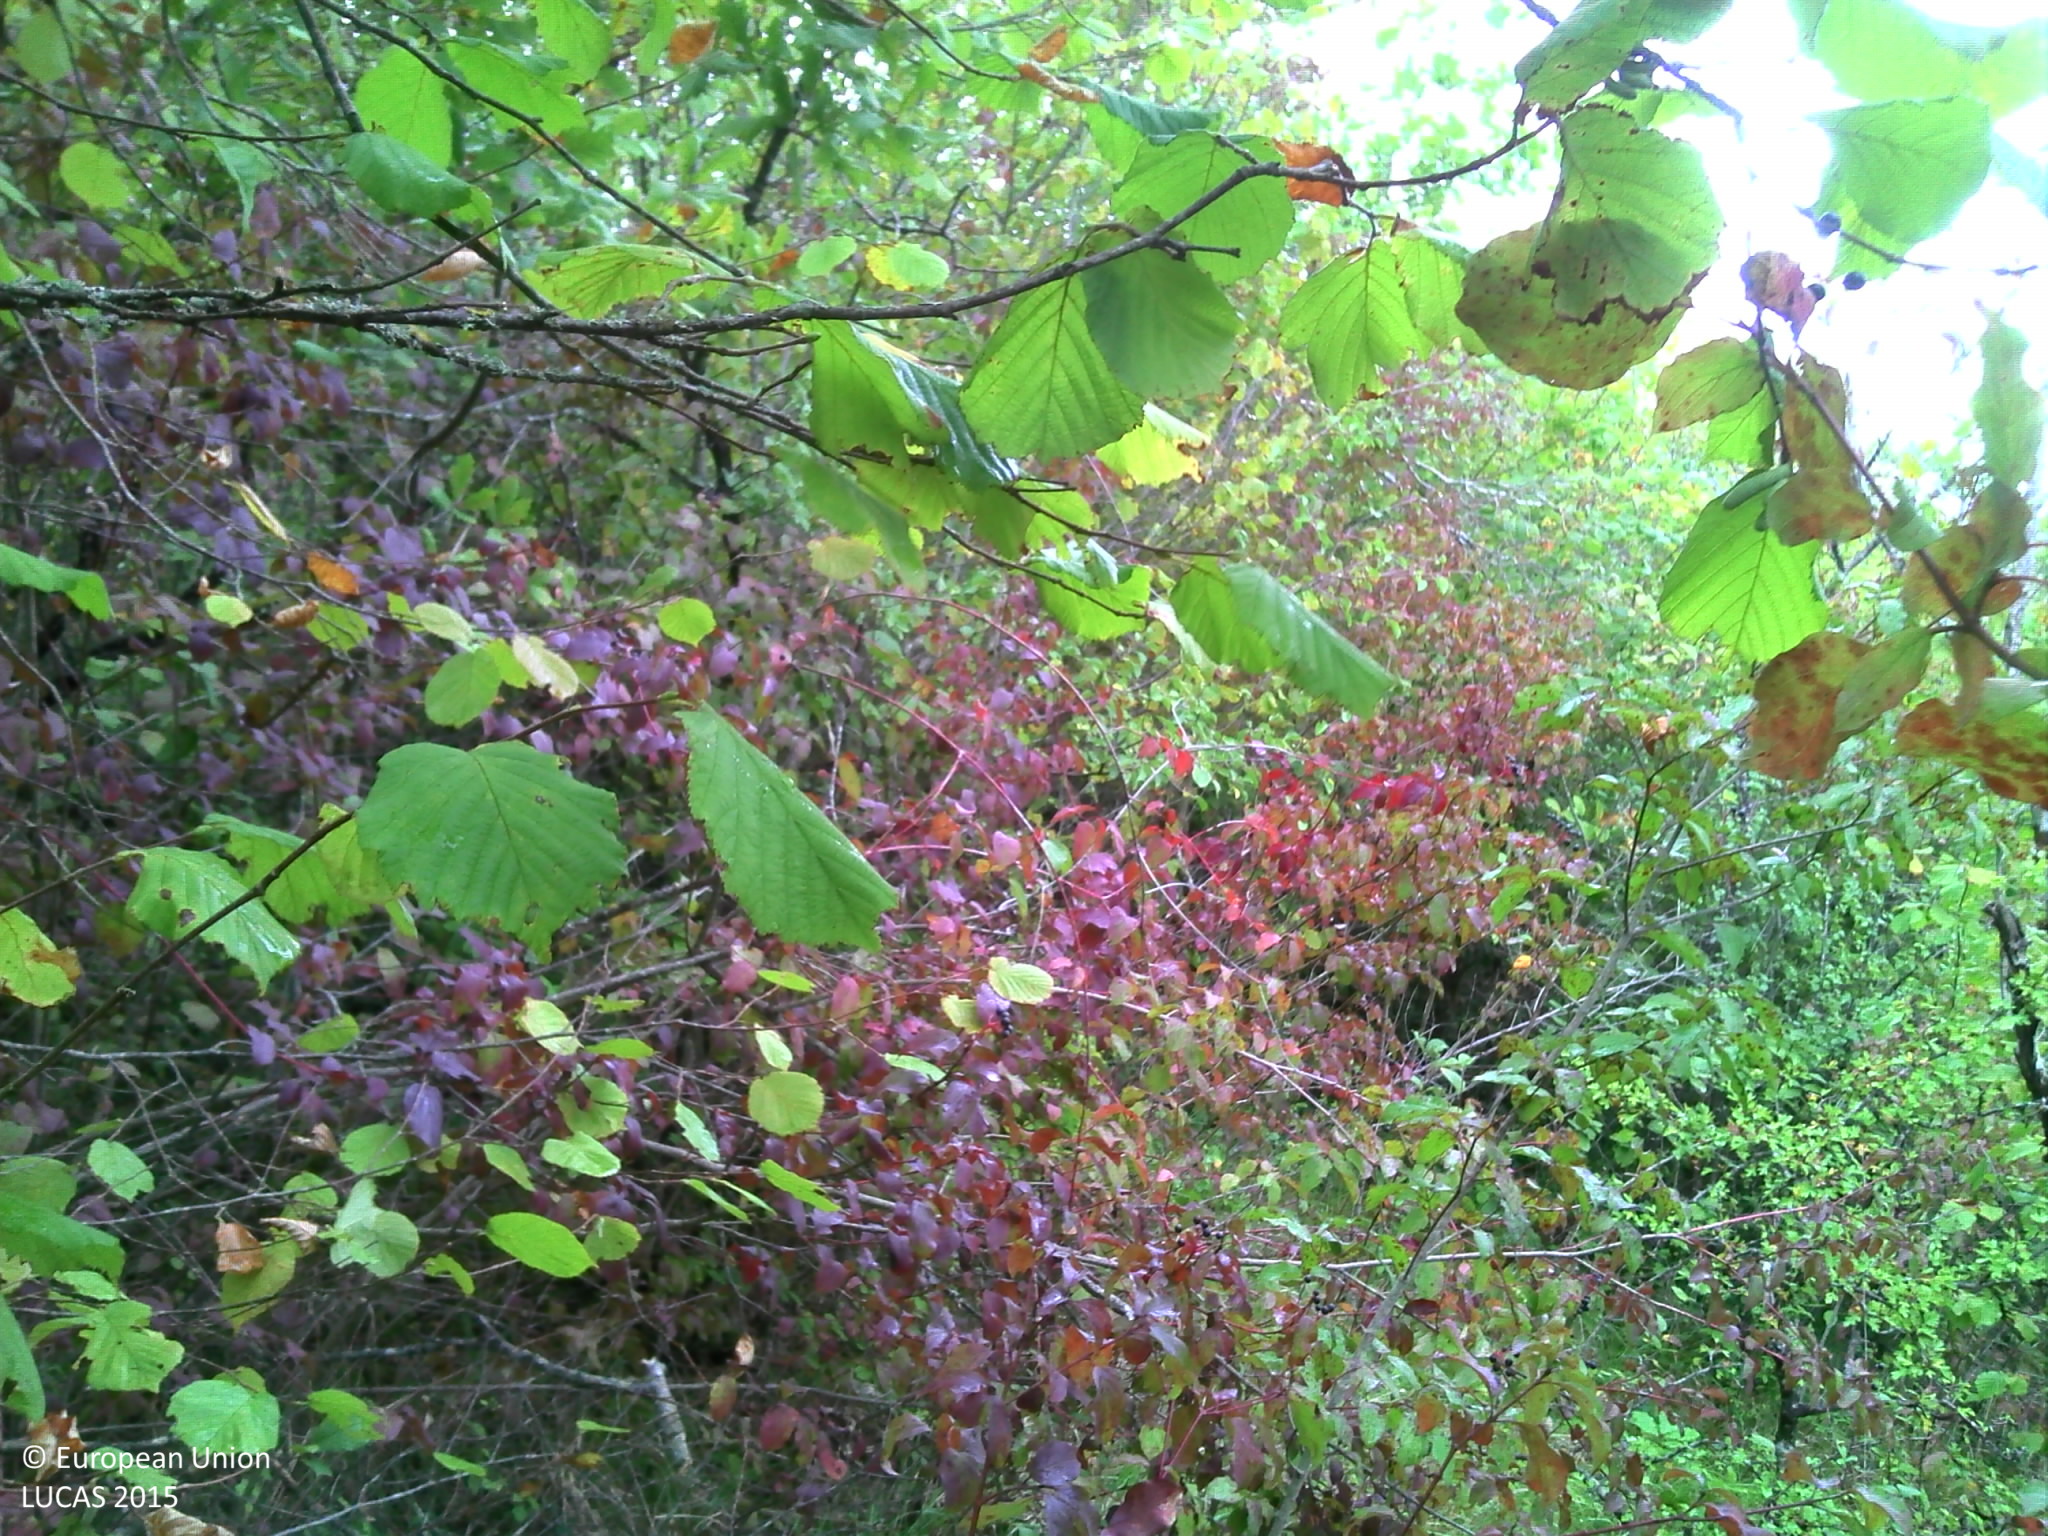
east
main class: Woodland
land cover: Broadleaved woodland
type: mesophytic deciduous forest
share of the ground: > 75 %
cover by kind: broadleaved forest trees 80 %, shrubs 10 %, herbaceous plants 10 %
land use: Semi-natural and natural areas not in use
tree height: < 5 m
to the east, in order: Broadleaved woodland; Shrubland with sparse tree cover; Spontaneously vegetated surfaces; Rocks and stones; Pine dominated mixed woodland
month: September
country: FR
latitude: 47.0343
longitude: 4.7499
